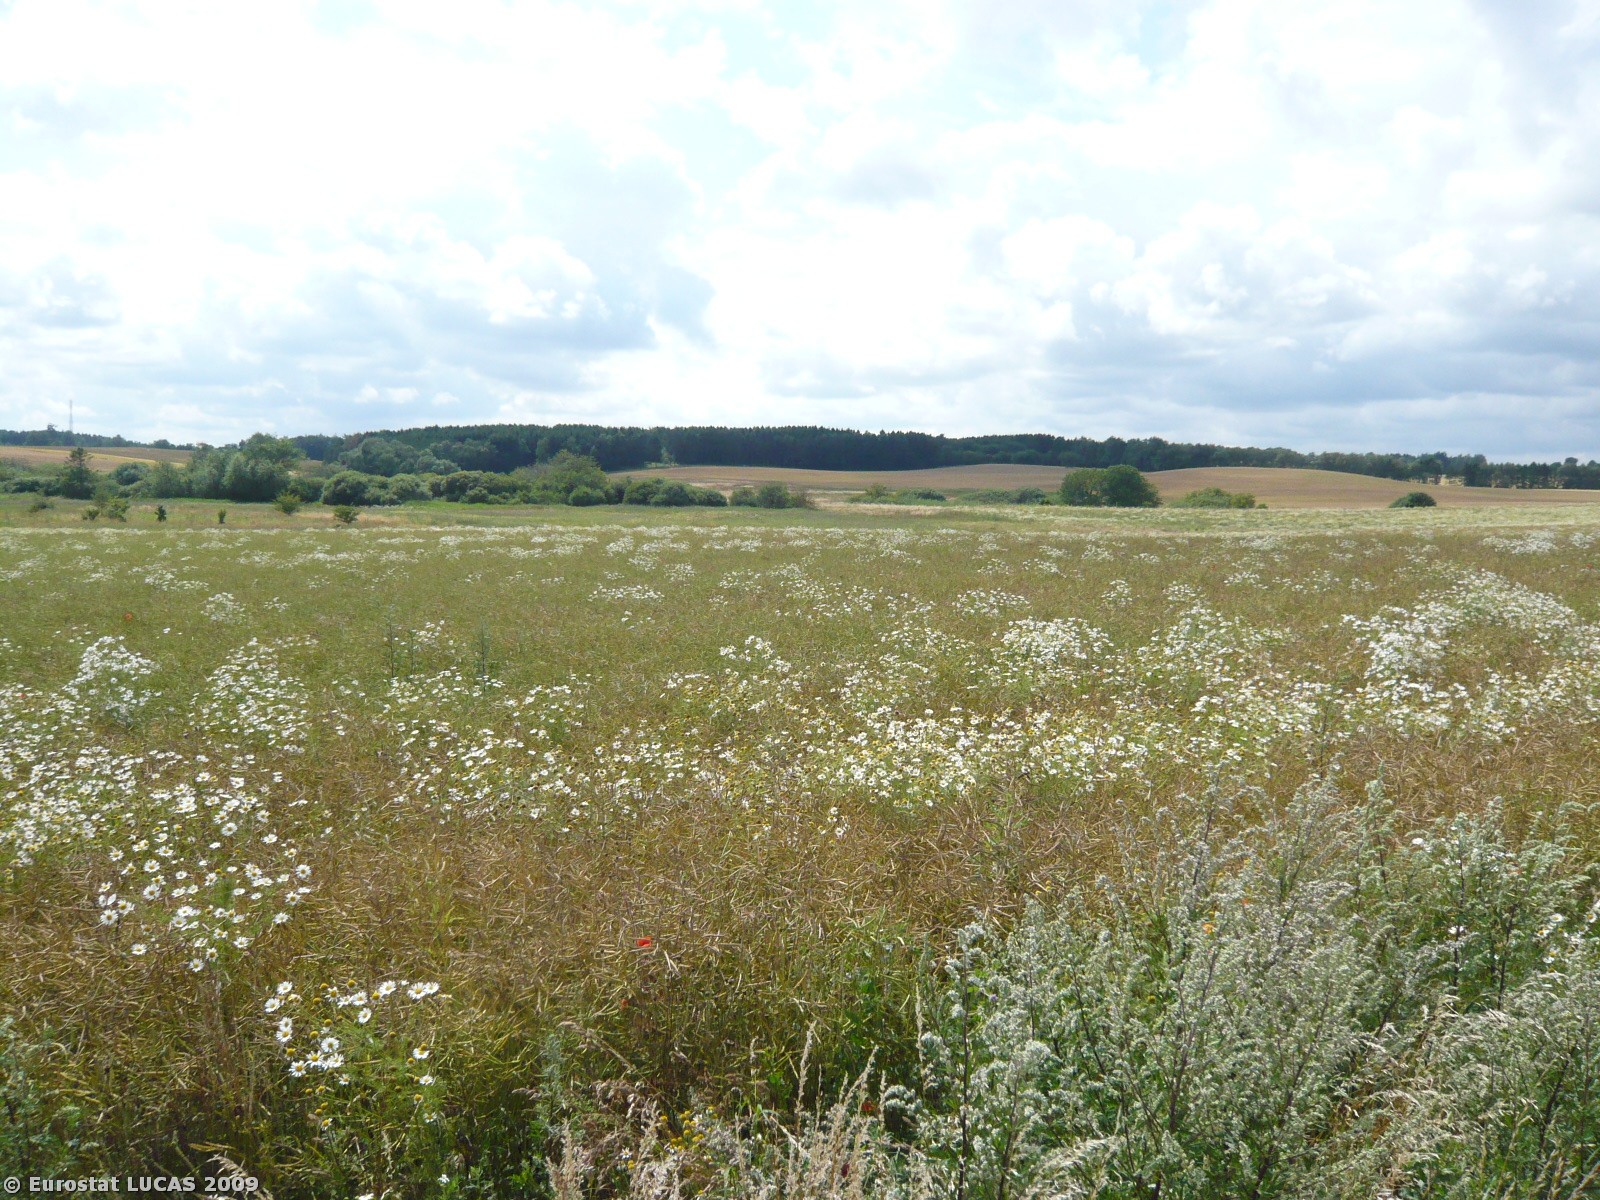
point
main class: Cropland
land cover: Rape and turnip rape
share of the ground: > 75 %
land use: Agriculture (excluding fallow land and kitchen gardens)
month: July
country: DK
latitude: 55.5092
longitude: 11.8511
